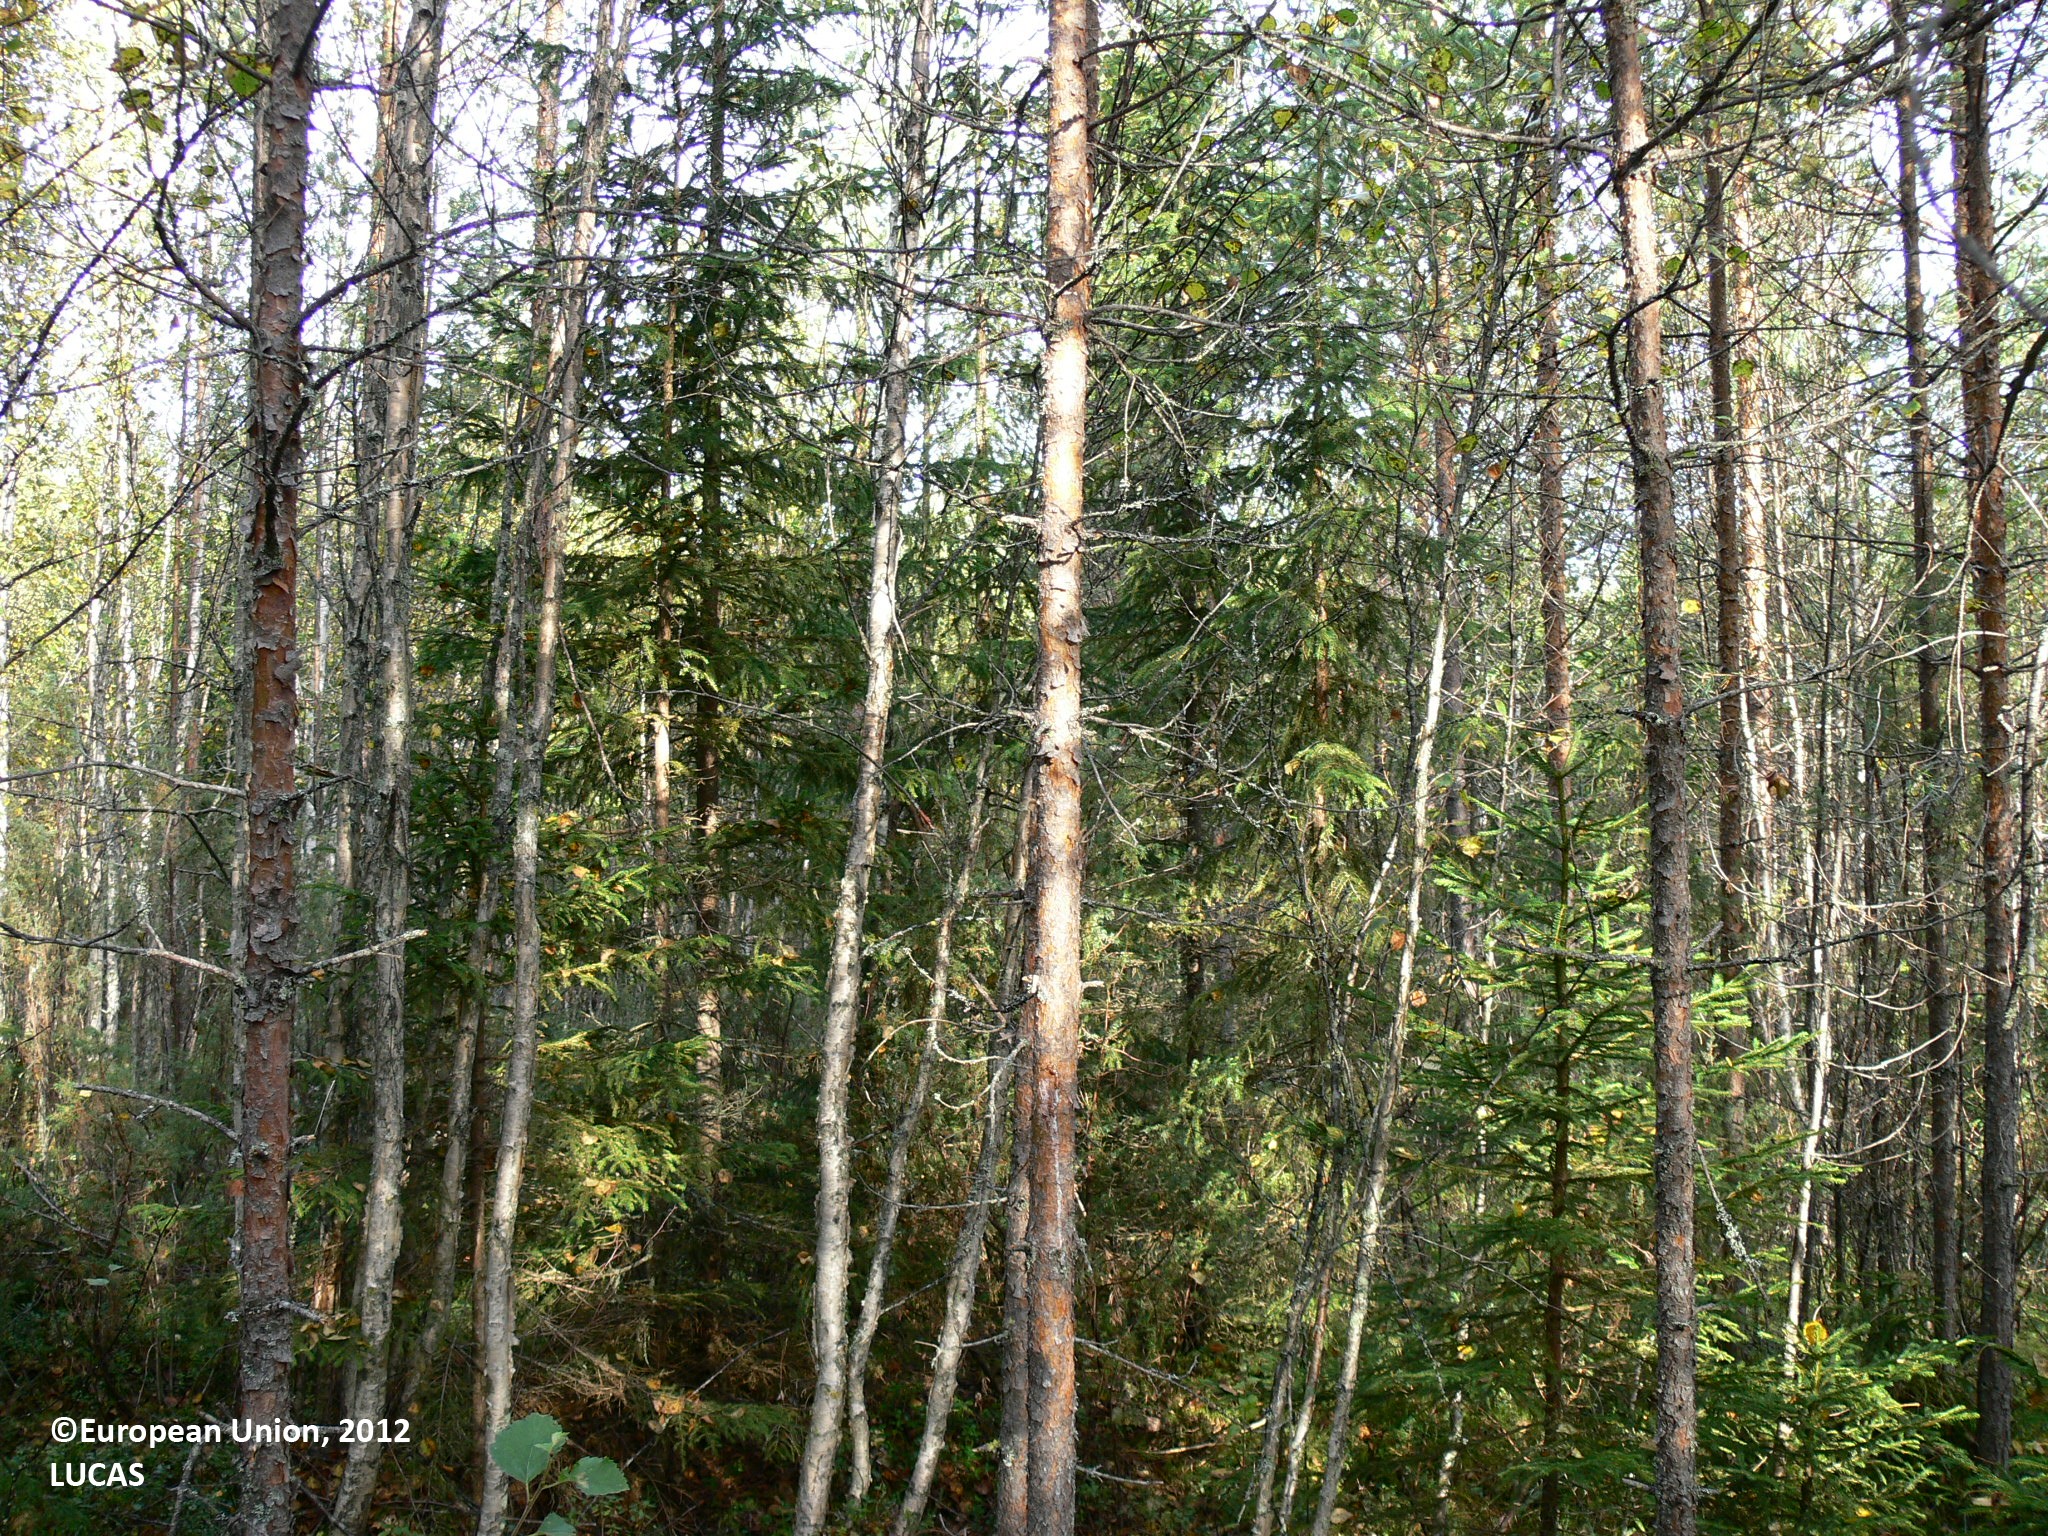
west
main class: Woodland
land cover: Other mixed woodland
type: boreal forest
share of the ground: > 75 %
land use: Forestry
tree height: > 5 m
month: September
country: FI
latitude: 63.2380
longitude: 30.1018
